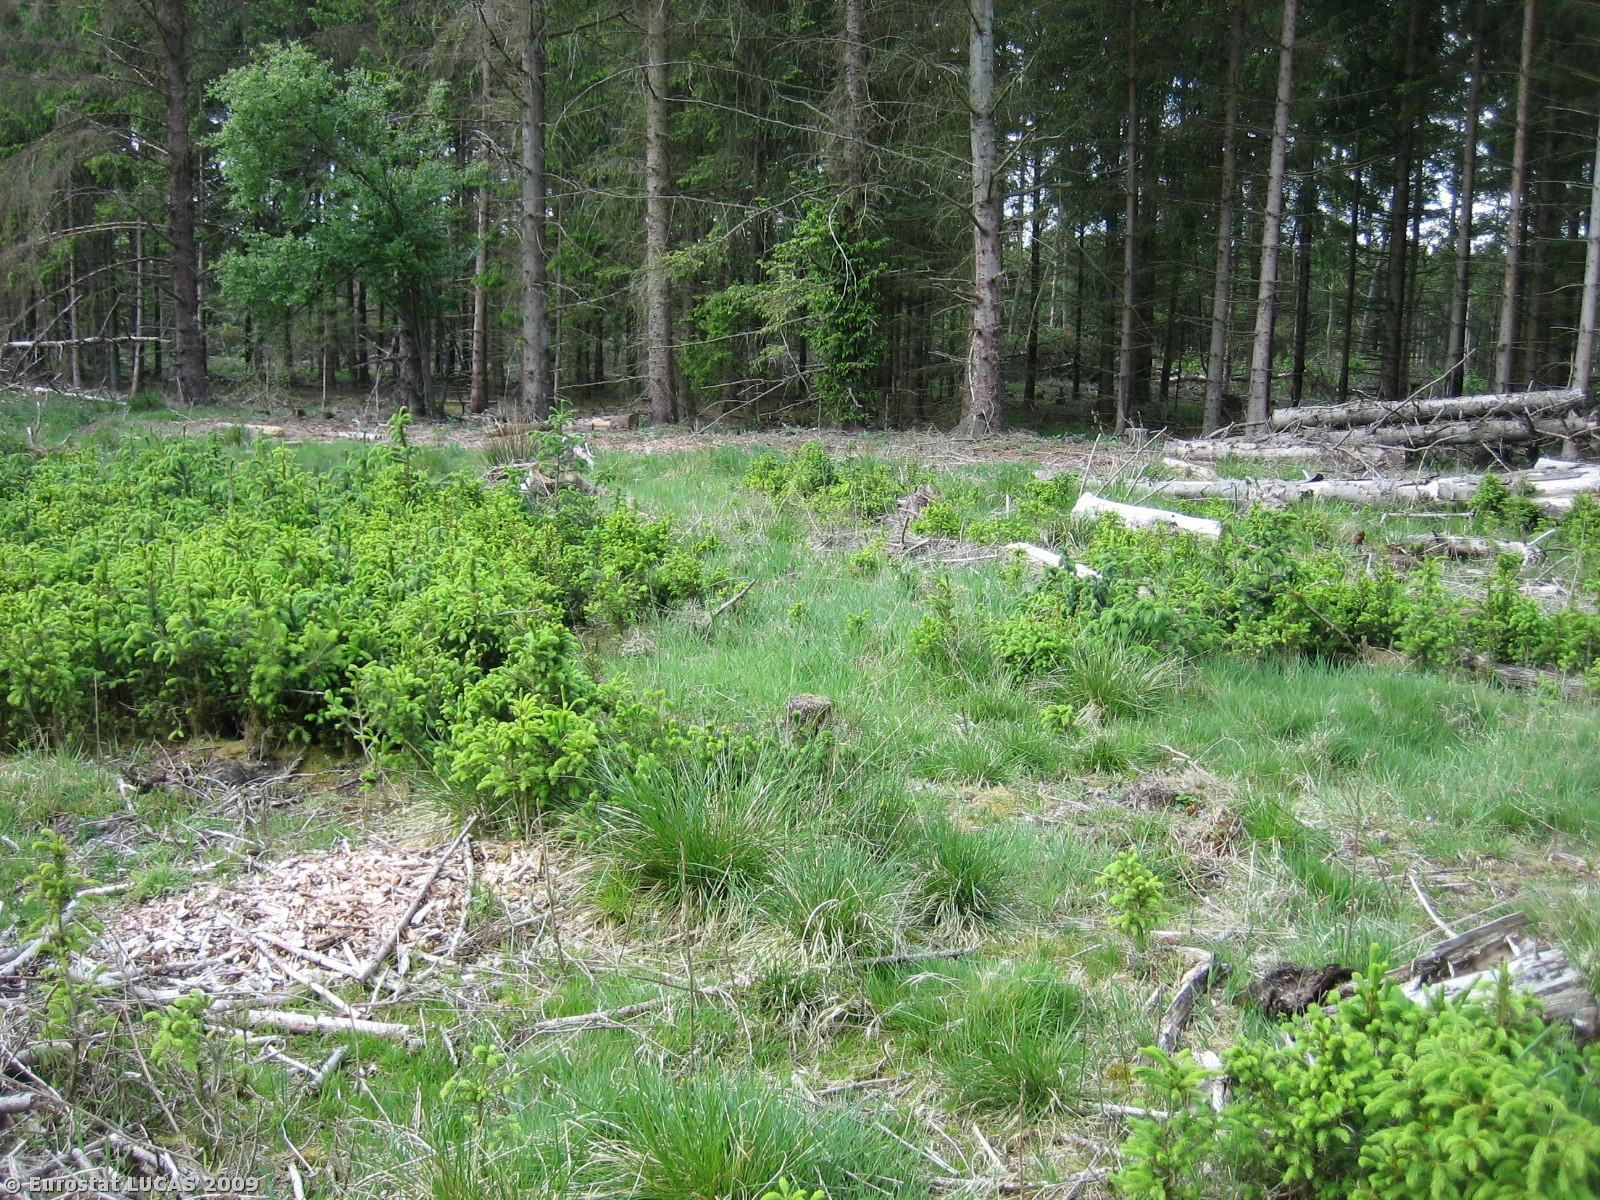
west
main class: Woodland
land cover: Coniferous woodland
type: hemiboreal forest and nemoral coniferous forest and mixed broadleaved-coniferous forest
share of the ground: 25 - 50 %
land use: Forestry
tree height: > 5 m
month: May
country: DK
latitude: 56.2551
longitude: 8.9198
